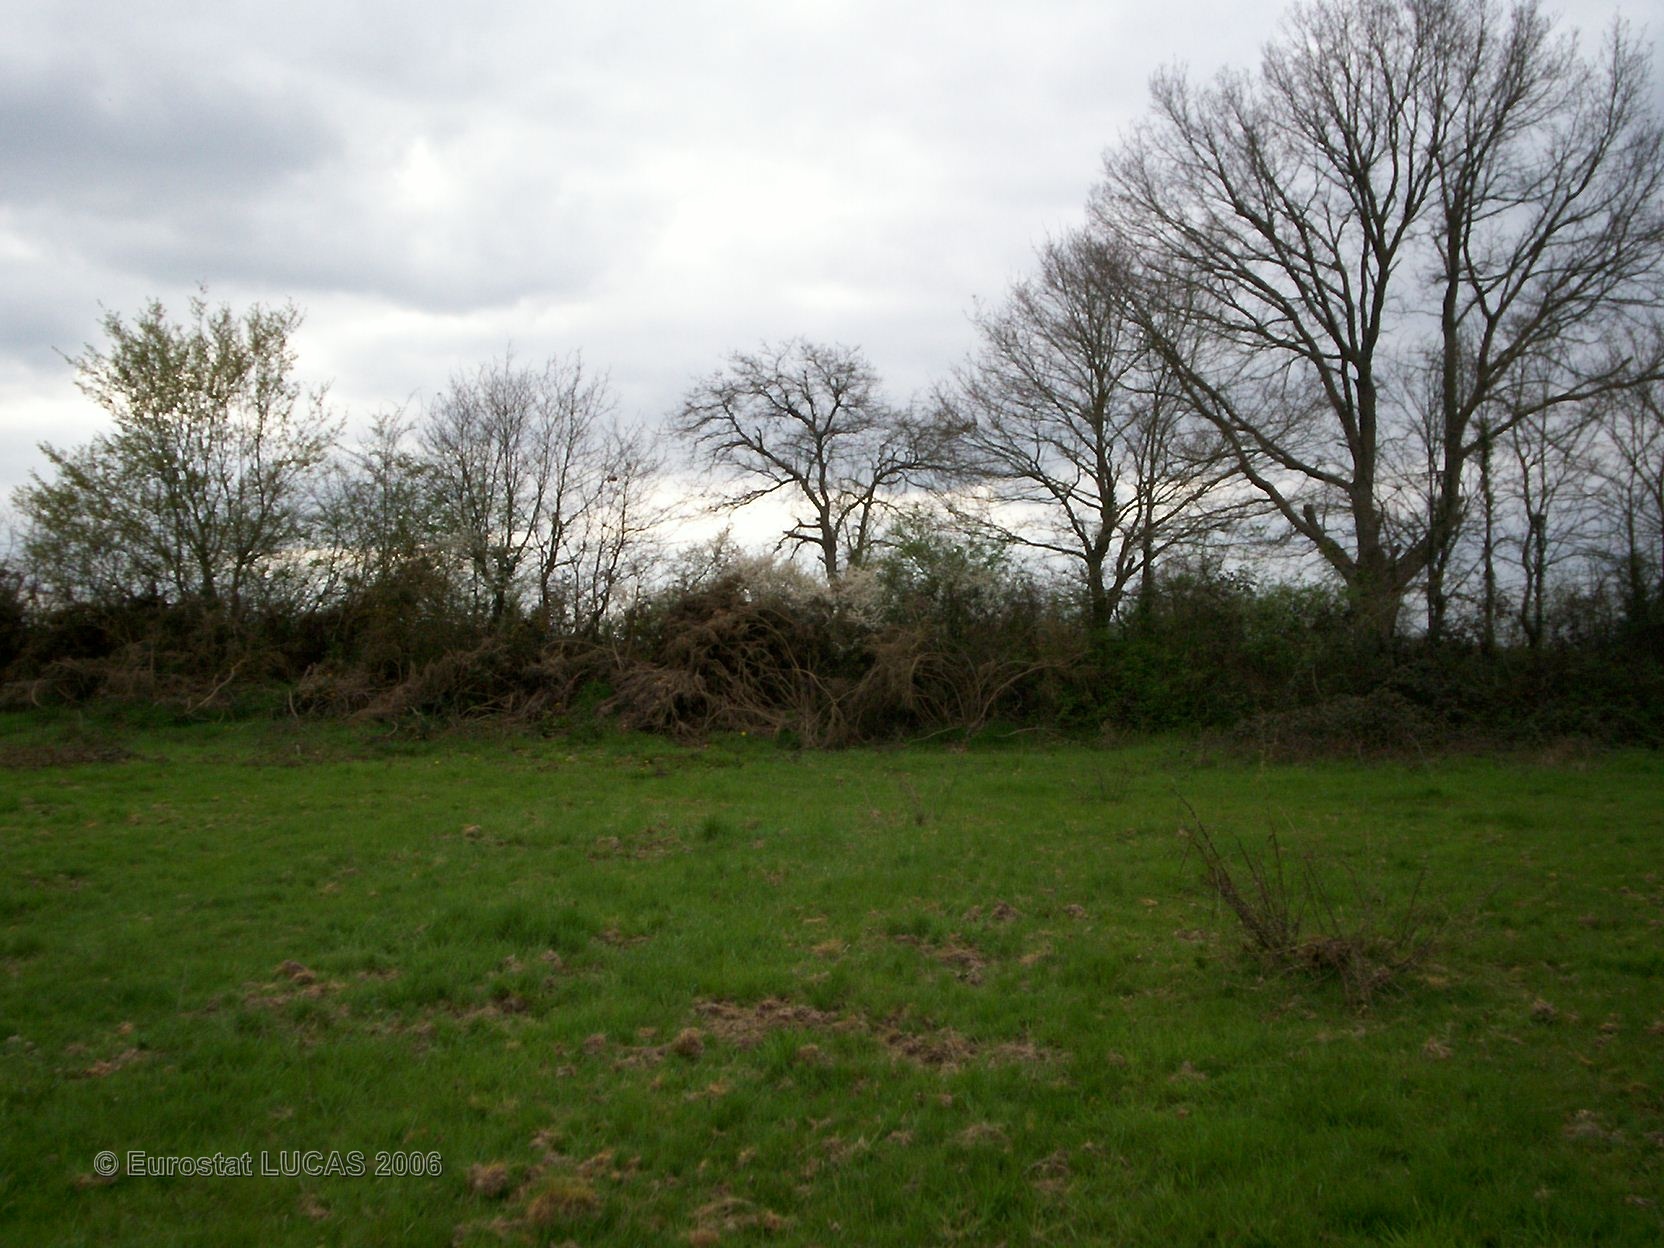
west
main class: Grassland
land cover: Grassland without tree/shrub cover
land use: Agriculture (excluding fallow land and kitchen gardens)
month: April
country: FR
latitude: 47.5617
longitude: 0.1265
